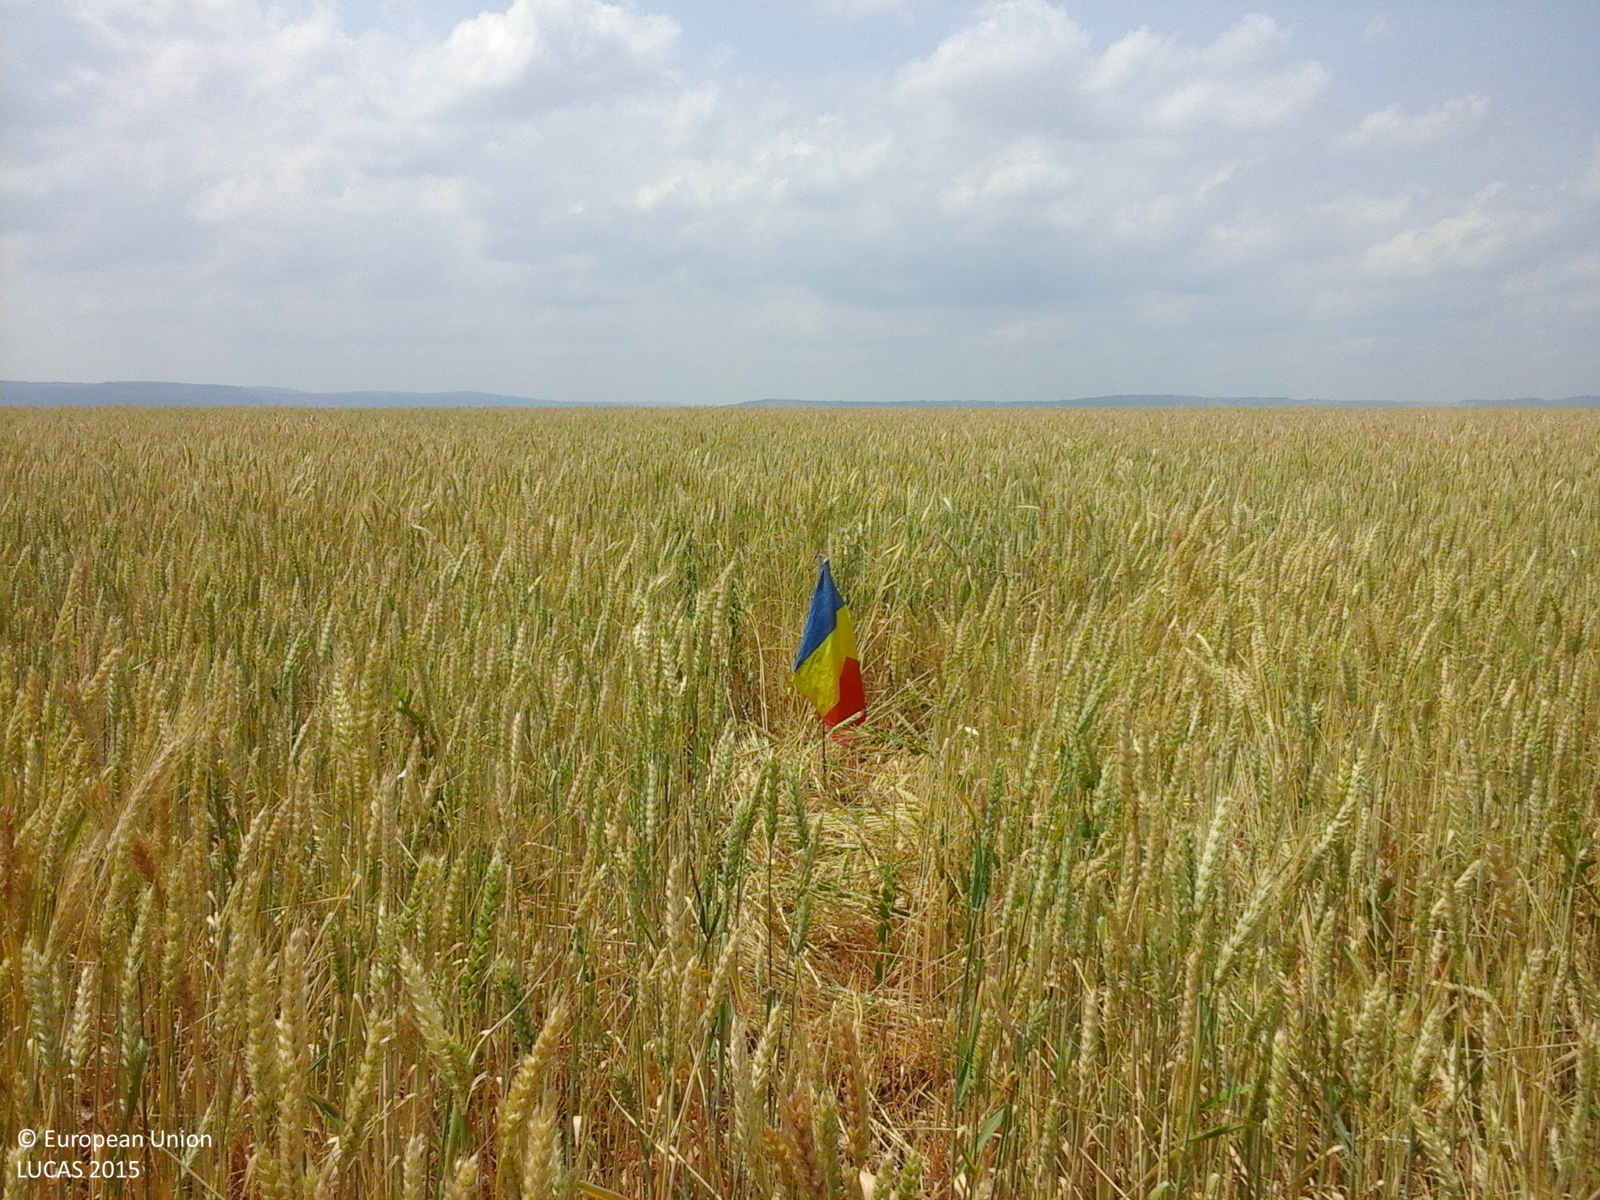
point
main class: Cropland
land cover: Common wheat
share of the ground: > 75 %
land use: Agriculture (excluding fallow land and kitchen gardens)
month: June
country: RO
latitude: 47.4443
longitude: 26.9838
